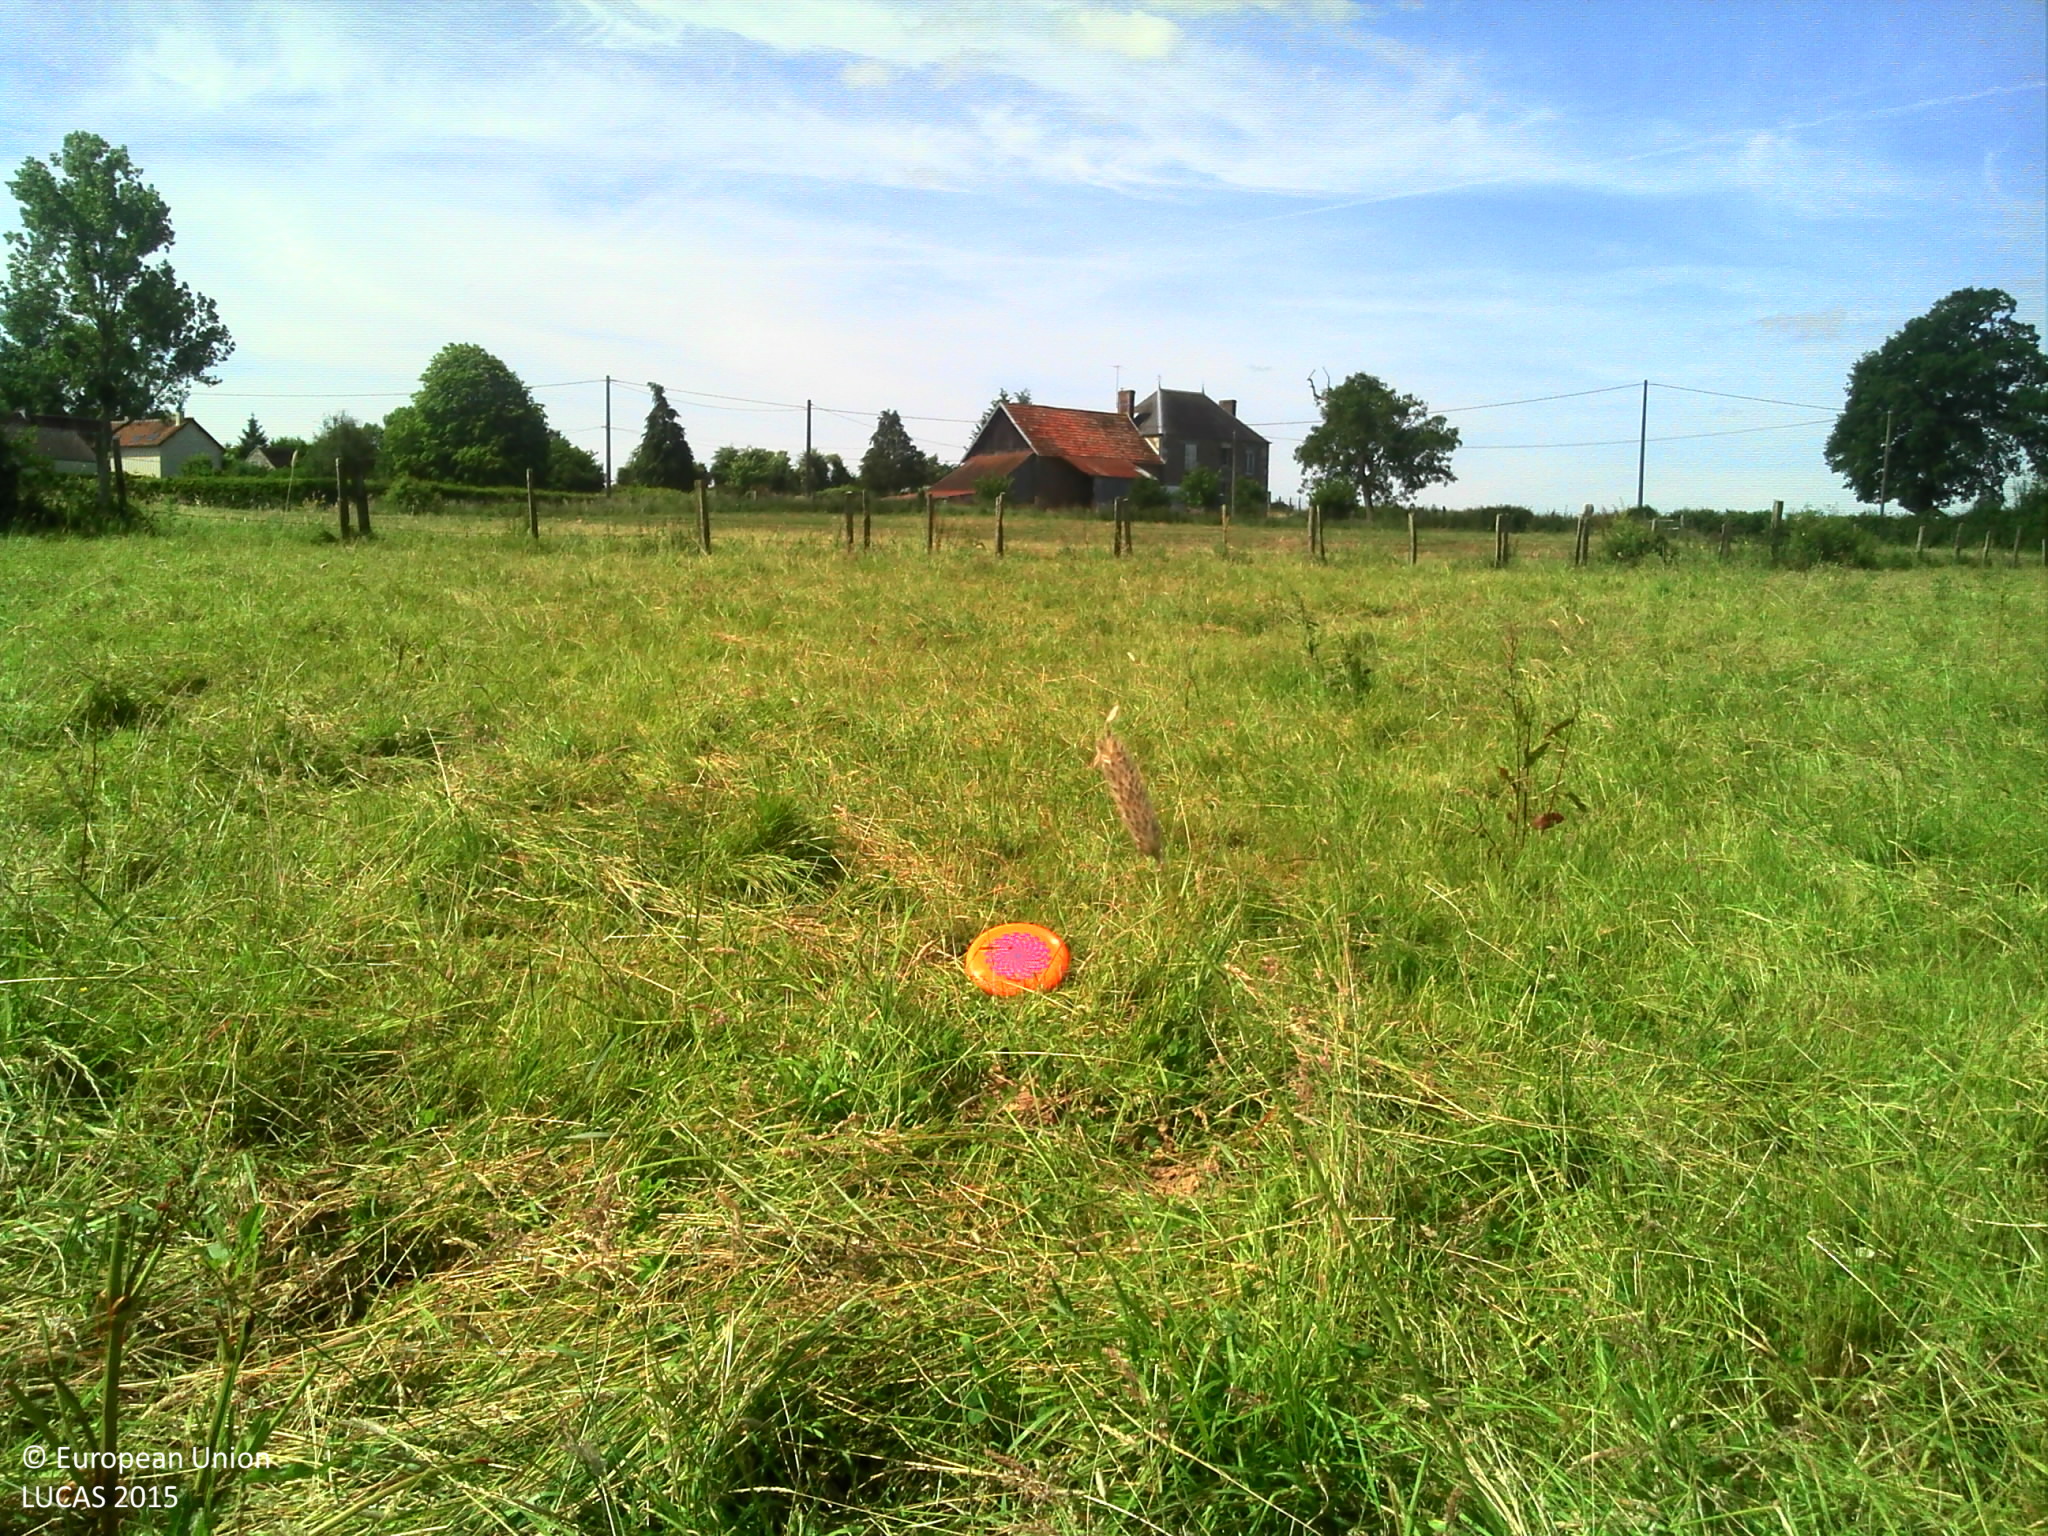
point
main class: Grassland
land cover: Grassland without tree/shrub cover
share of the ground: > 75 %
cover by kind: herbaceous plants 100 %
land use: Agriculture (excluding fallow land and kitchen gardens)
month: June
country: FR
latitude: 48.6277
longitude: -0.1119
